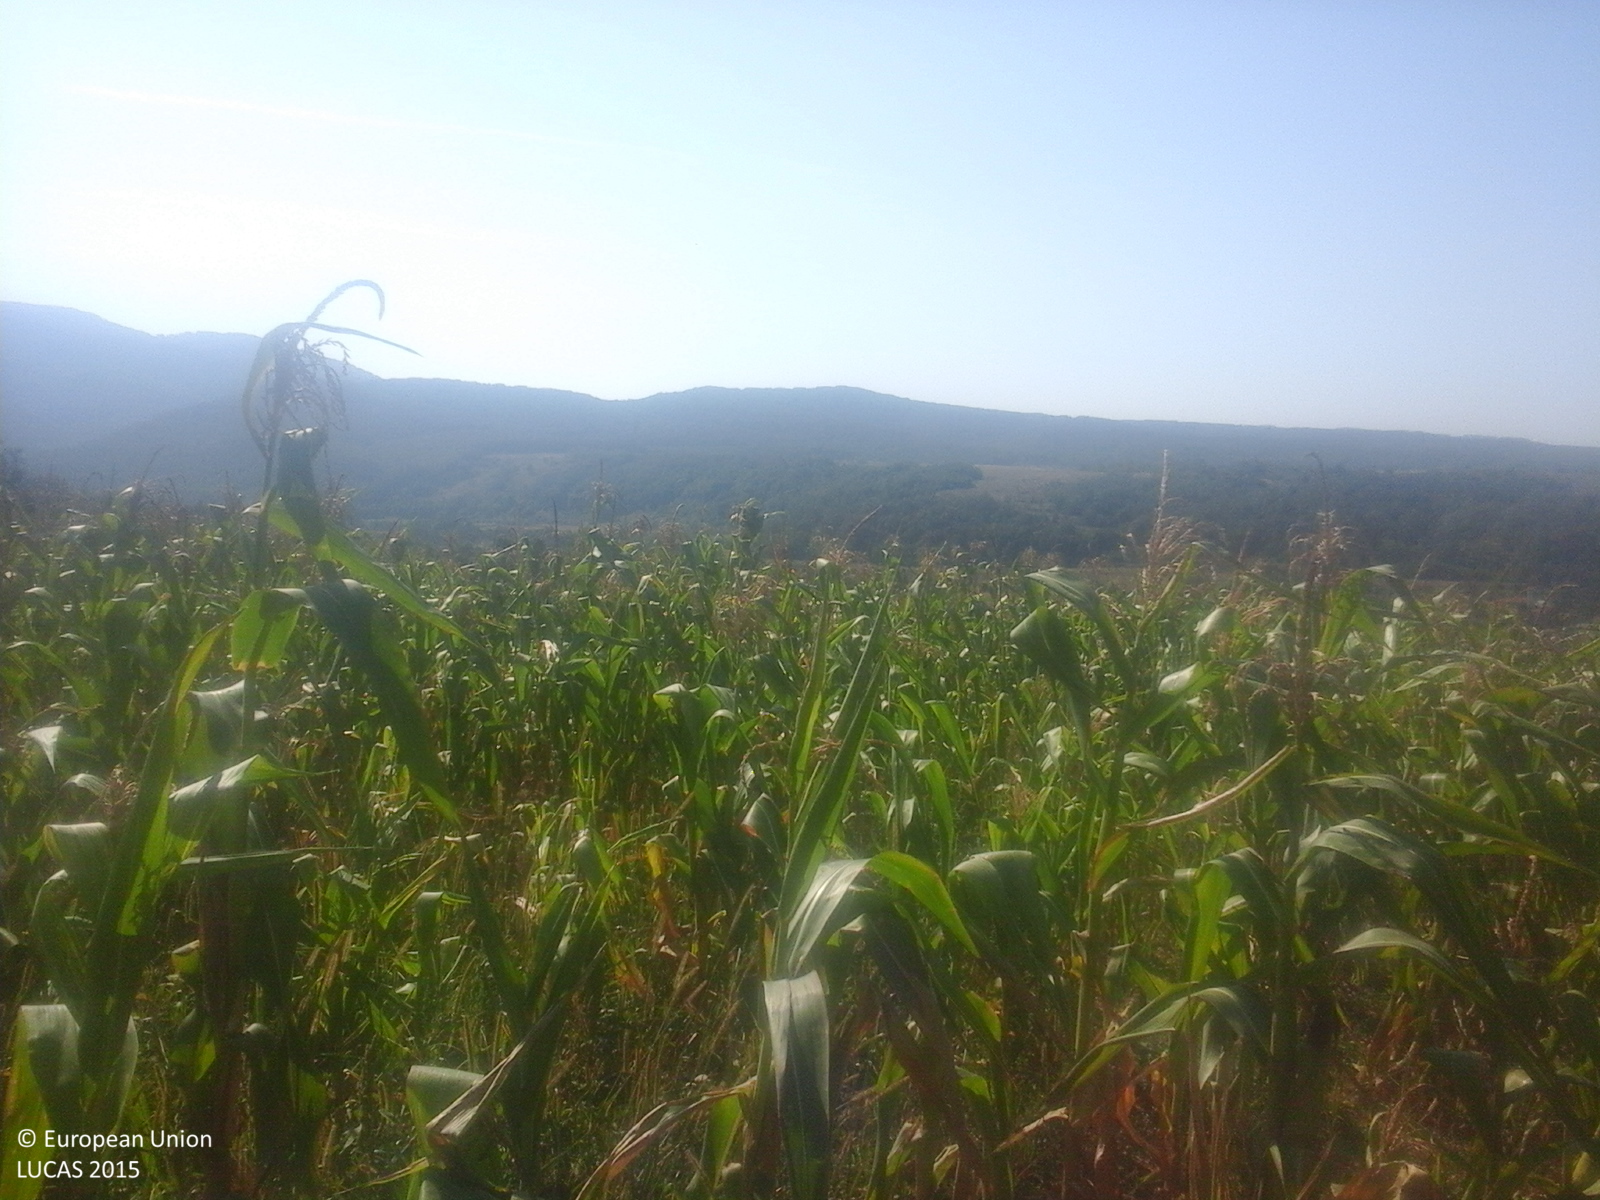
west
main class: Grassland
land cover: Grassland without tree/shrub cover
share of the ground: > 75 %
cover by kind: herbaceous plants 100 %
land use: Agriculture (excluding fallow land and kitchen gardens)
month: September
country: RO
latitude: 46.6379
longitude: 22.3160
